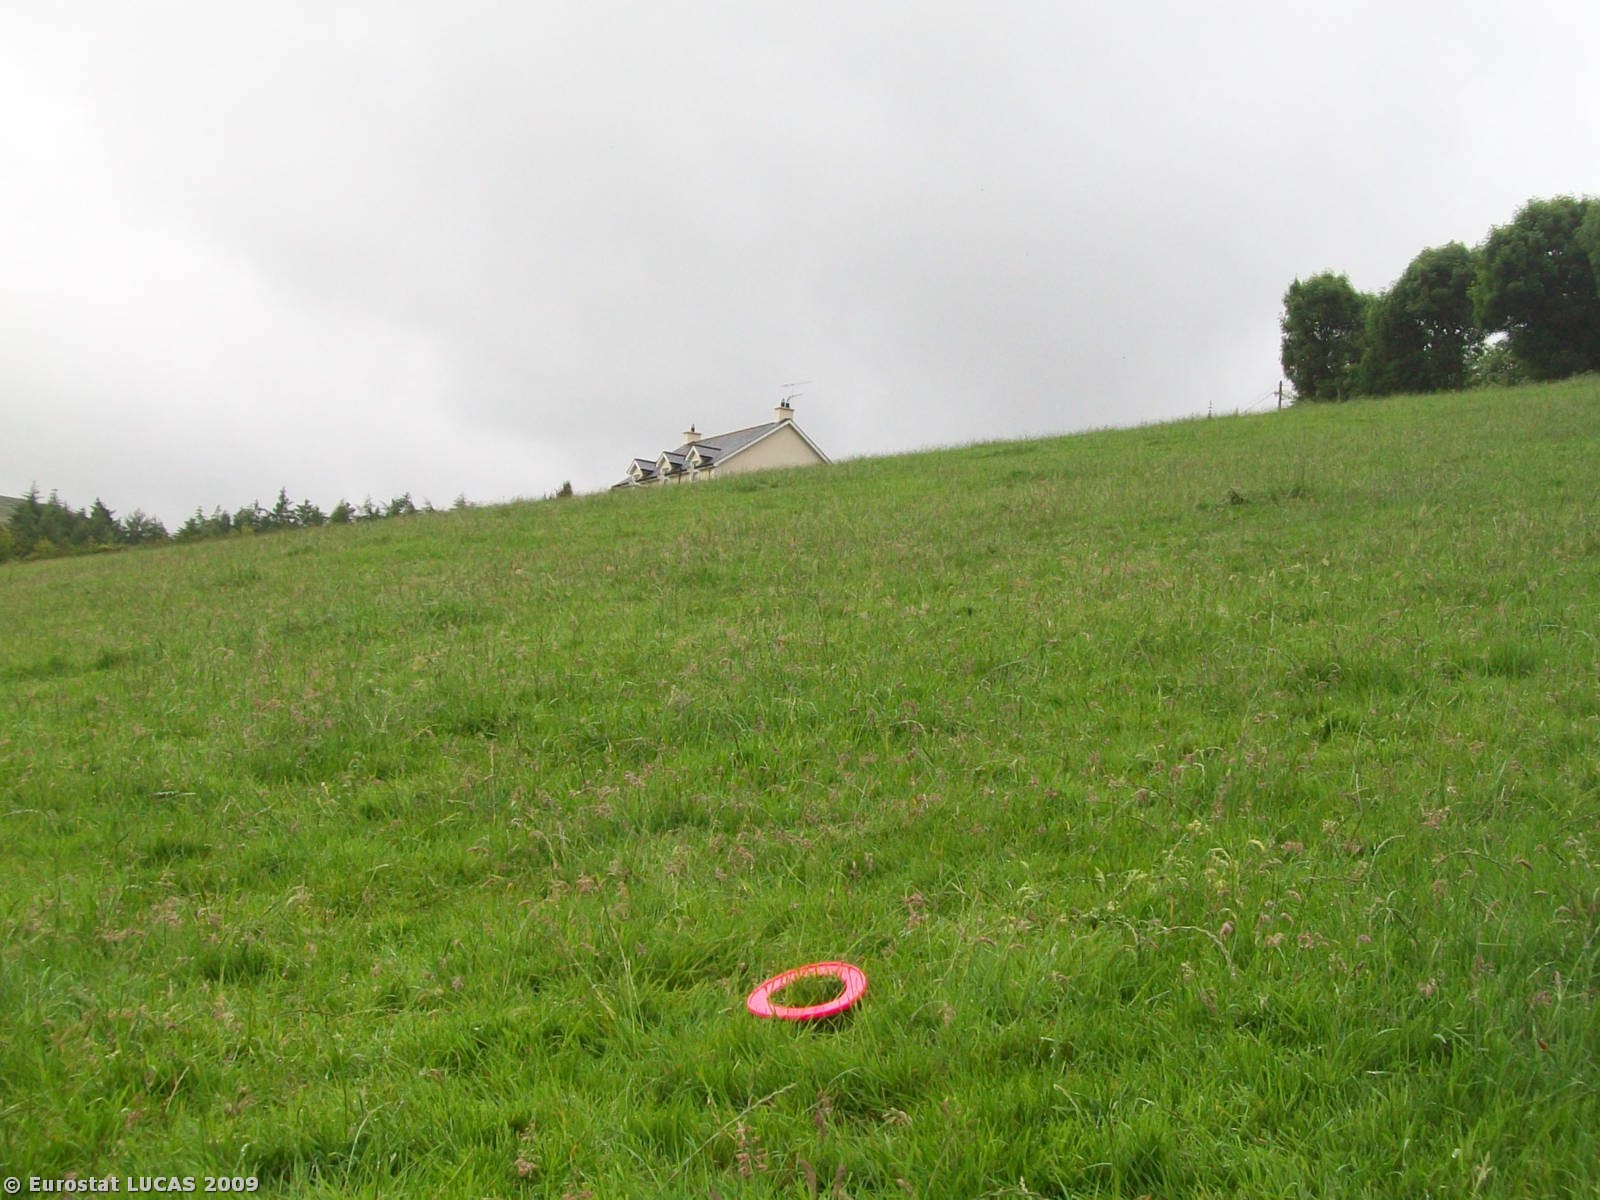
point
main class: Grassland
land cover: Grassland without tree/shrub cover
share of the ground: > 75 %
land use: Agriculture (excluding fallow land and kitchen gardens)
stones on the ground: < 10 %
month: July
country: GB
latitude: 54.7601
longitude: -7.1605
